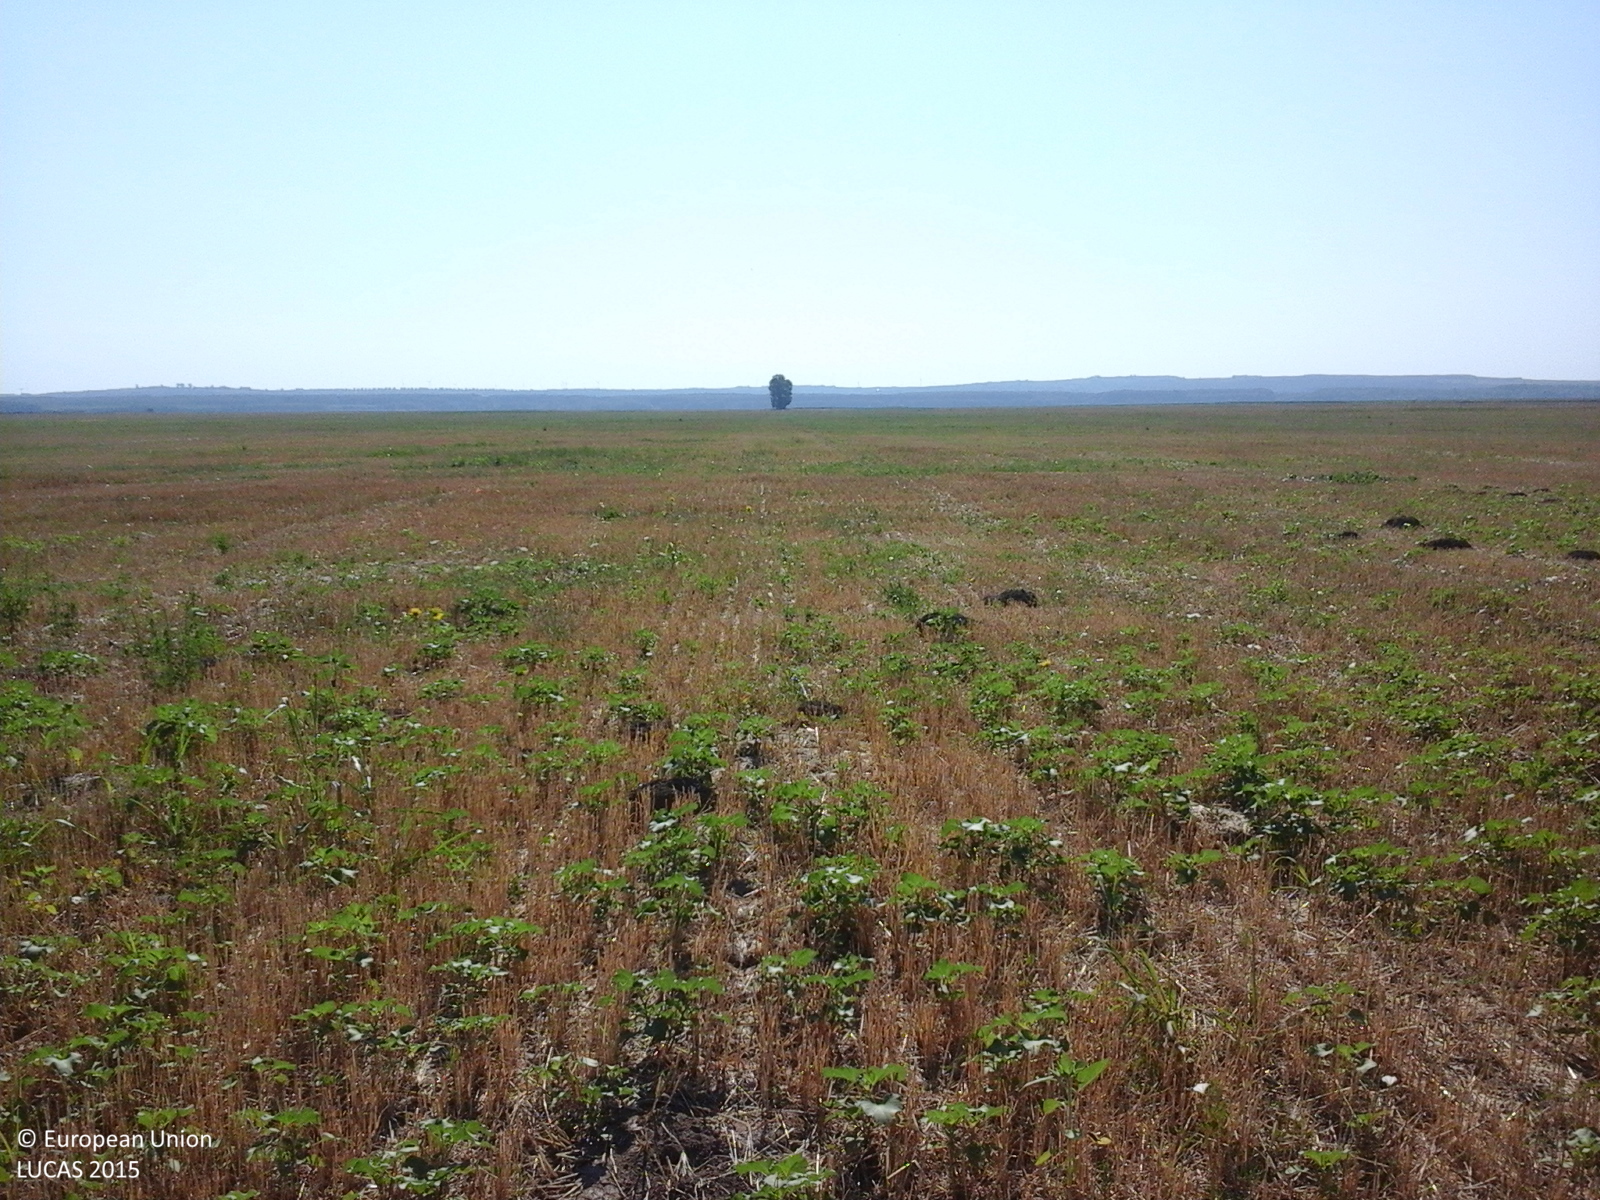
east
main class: Cropland
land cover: Durum wheat
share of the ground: 25 - 50 %
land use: Agriculture (excluding fallow land and kitchen gardens)
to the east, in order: Durum wheat
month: July
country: RO
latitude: 44.3194
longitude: 27.9460
